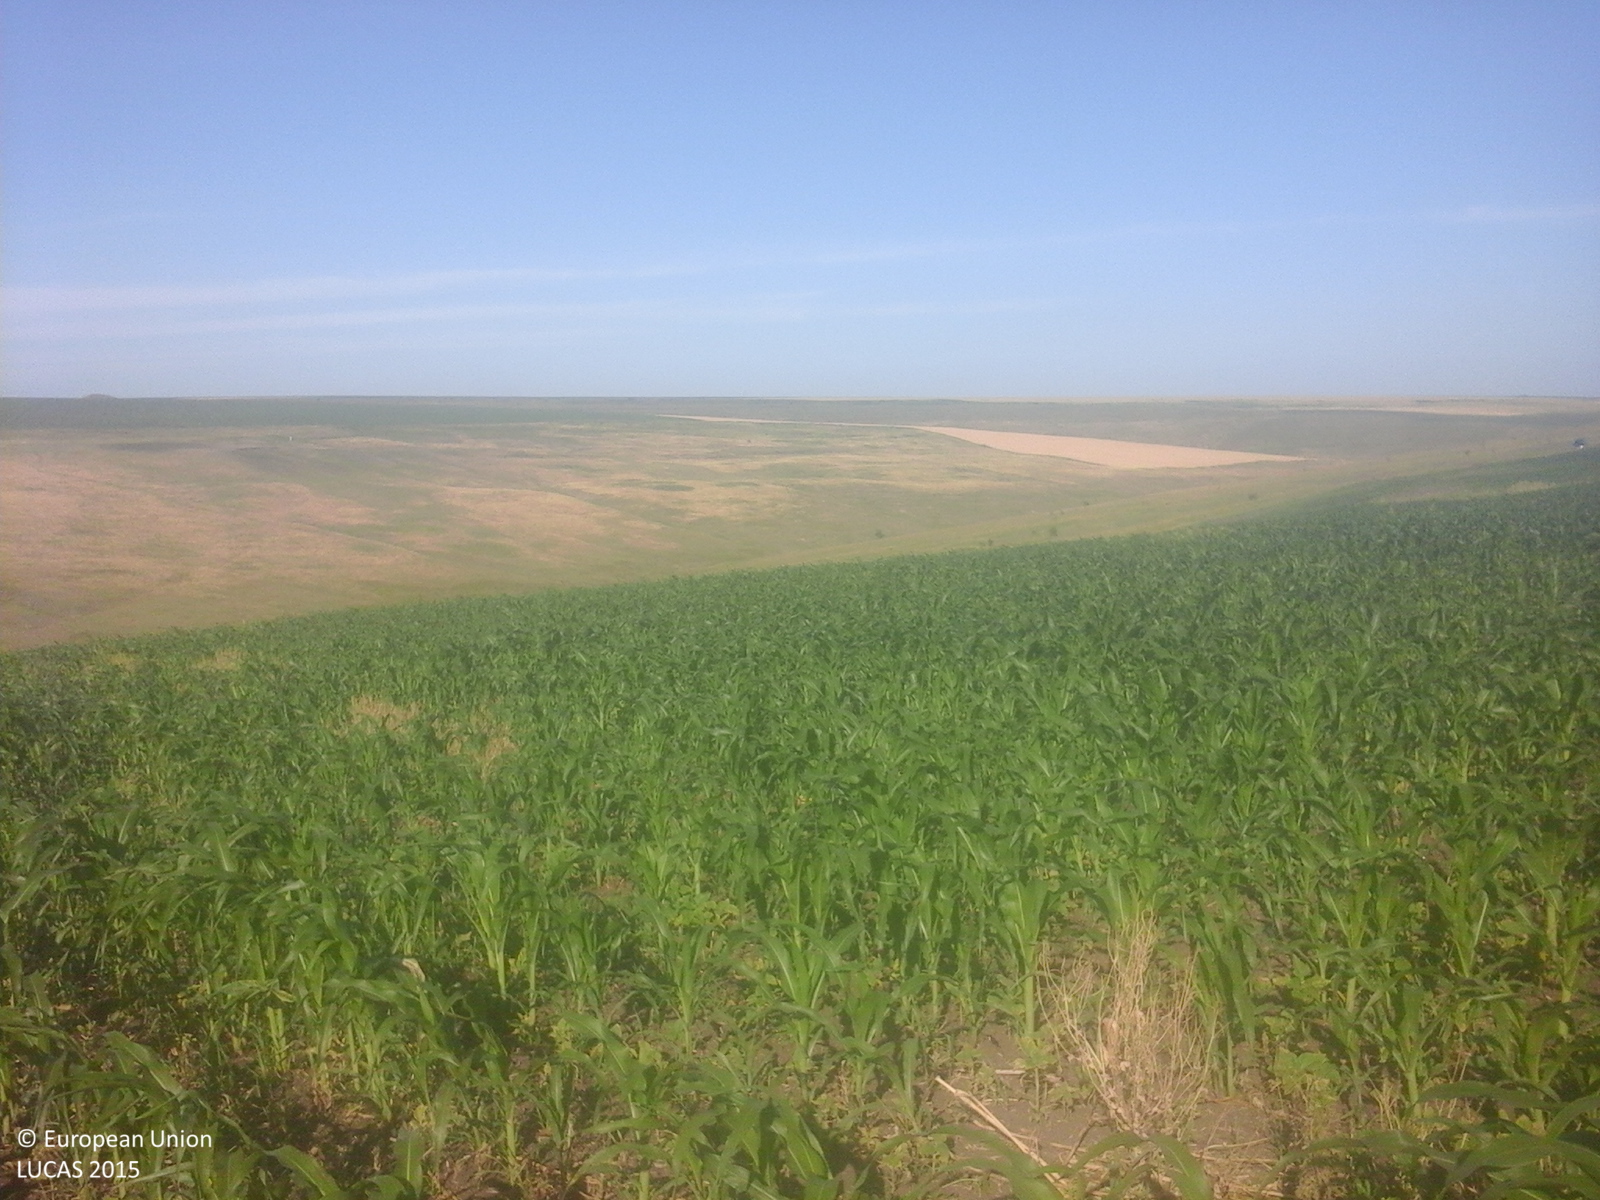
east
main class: Cropland
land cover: Maize
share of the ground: 50 - 75 %
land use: Agriculture (excluding fallow land and kitchen gardens)
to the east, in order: Maize; Grassland with sparse tree/shrub cover
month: June
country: RO
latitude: 47.9187
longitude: 27.0071
